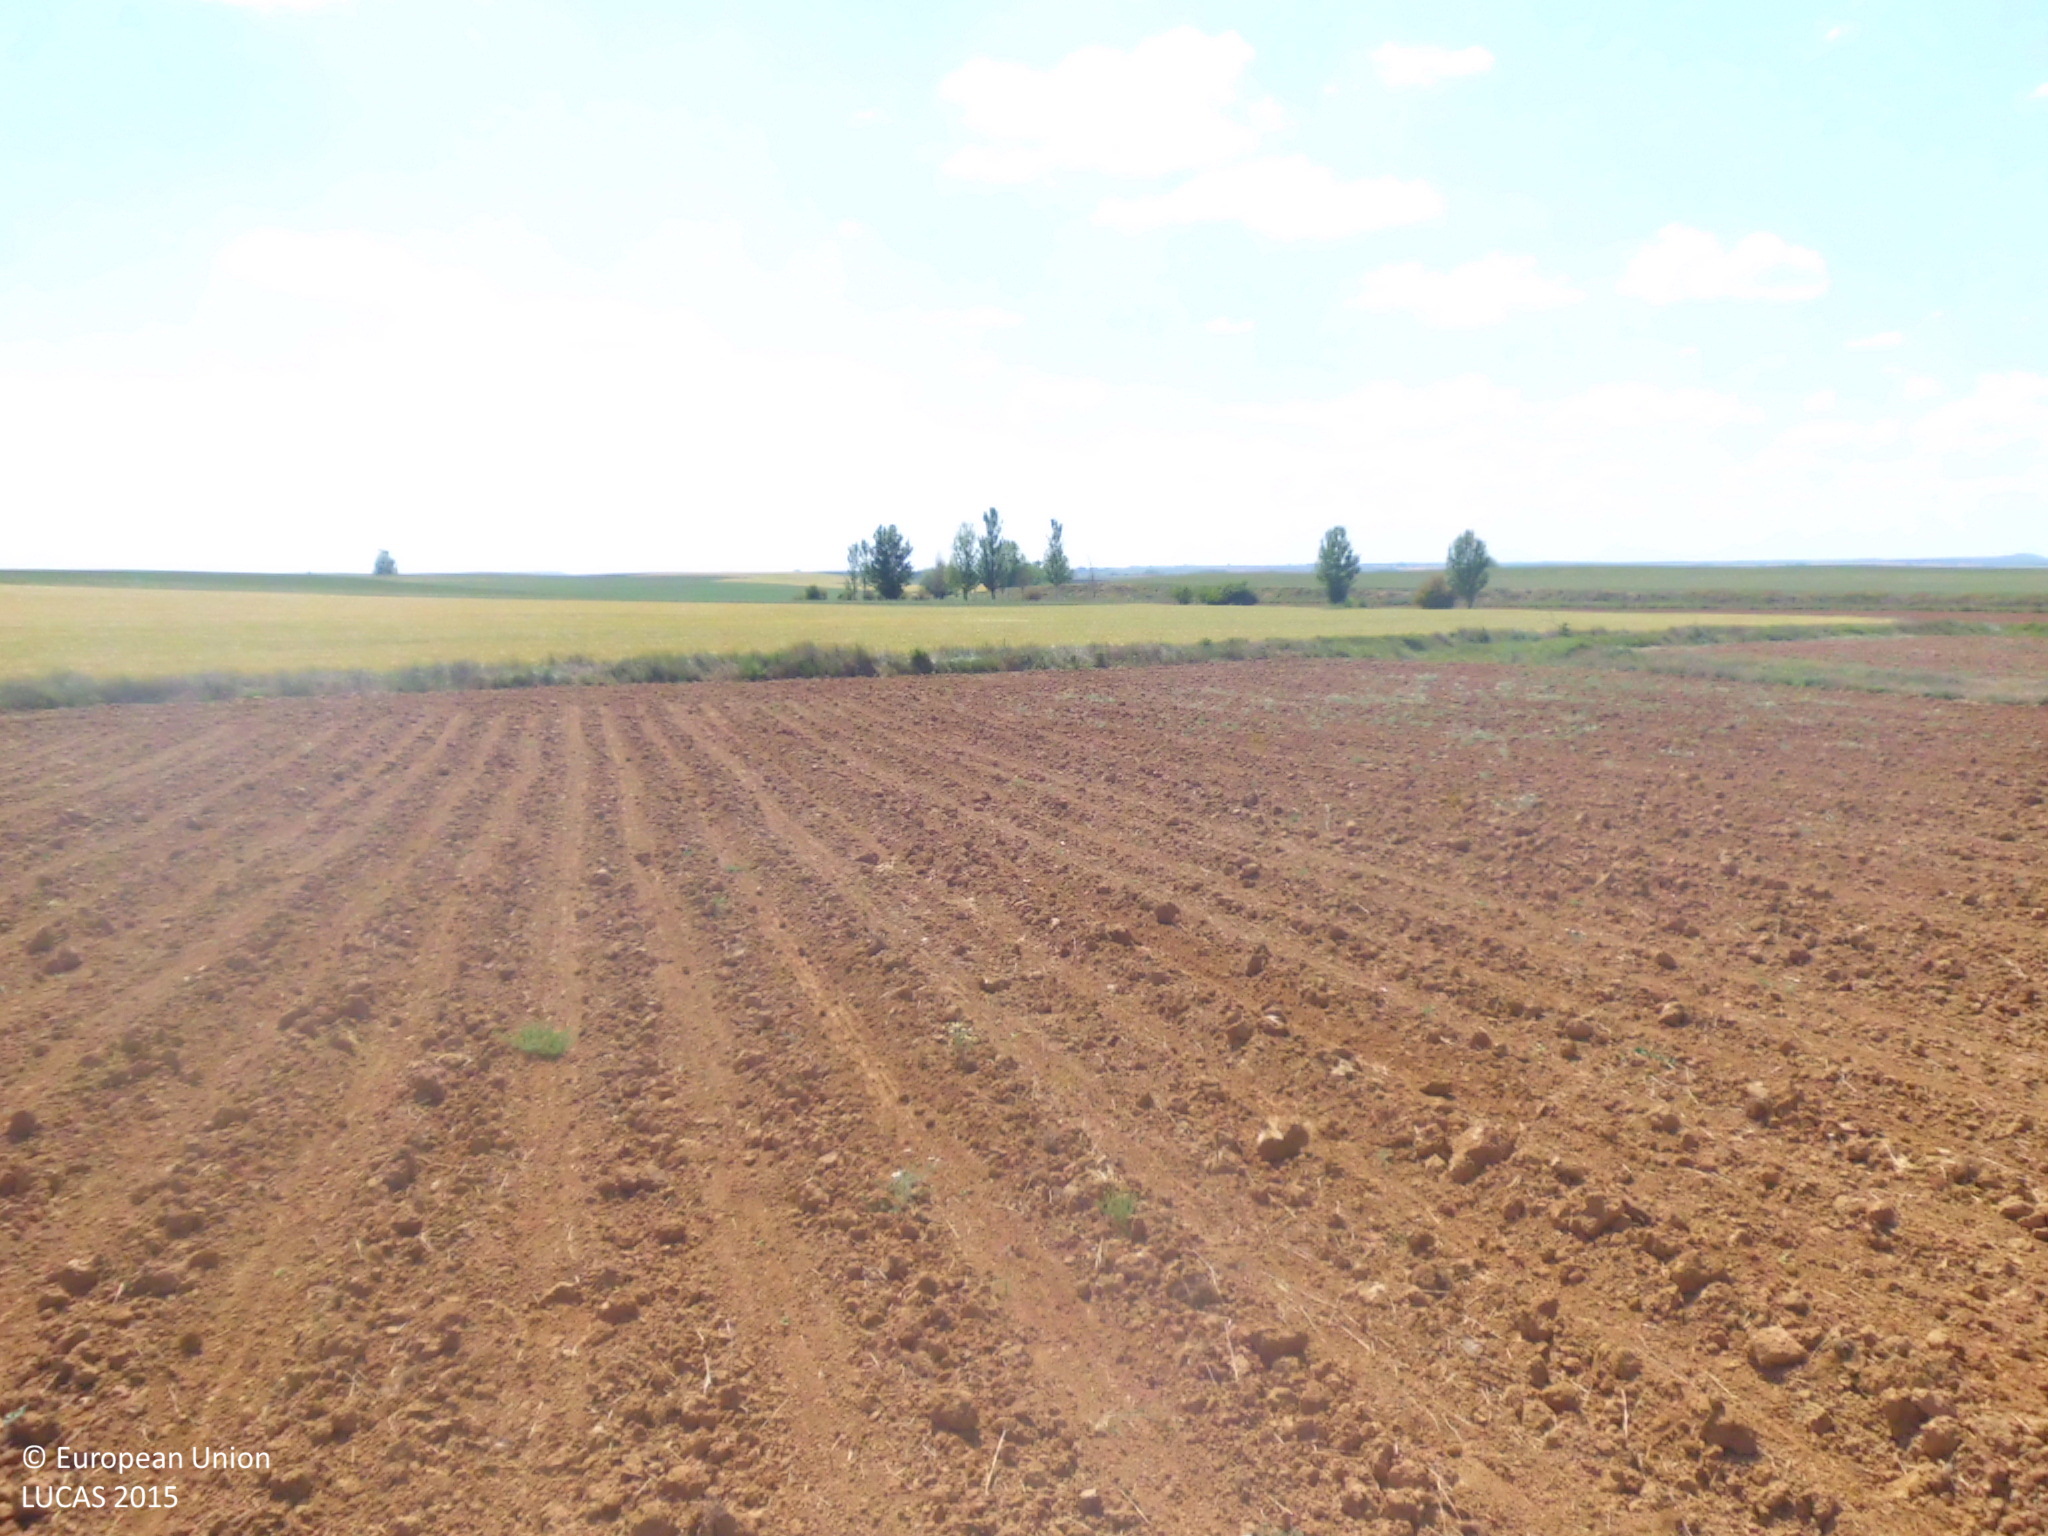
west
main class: Cropland
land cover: Sunflower
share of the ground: < 10 %
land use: Agriculture (excluding fallow land and kitchen gardens)
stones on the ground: < 10 %
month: June
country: ES
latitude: 42.4340
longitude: -4.2068
